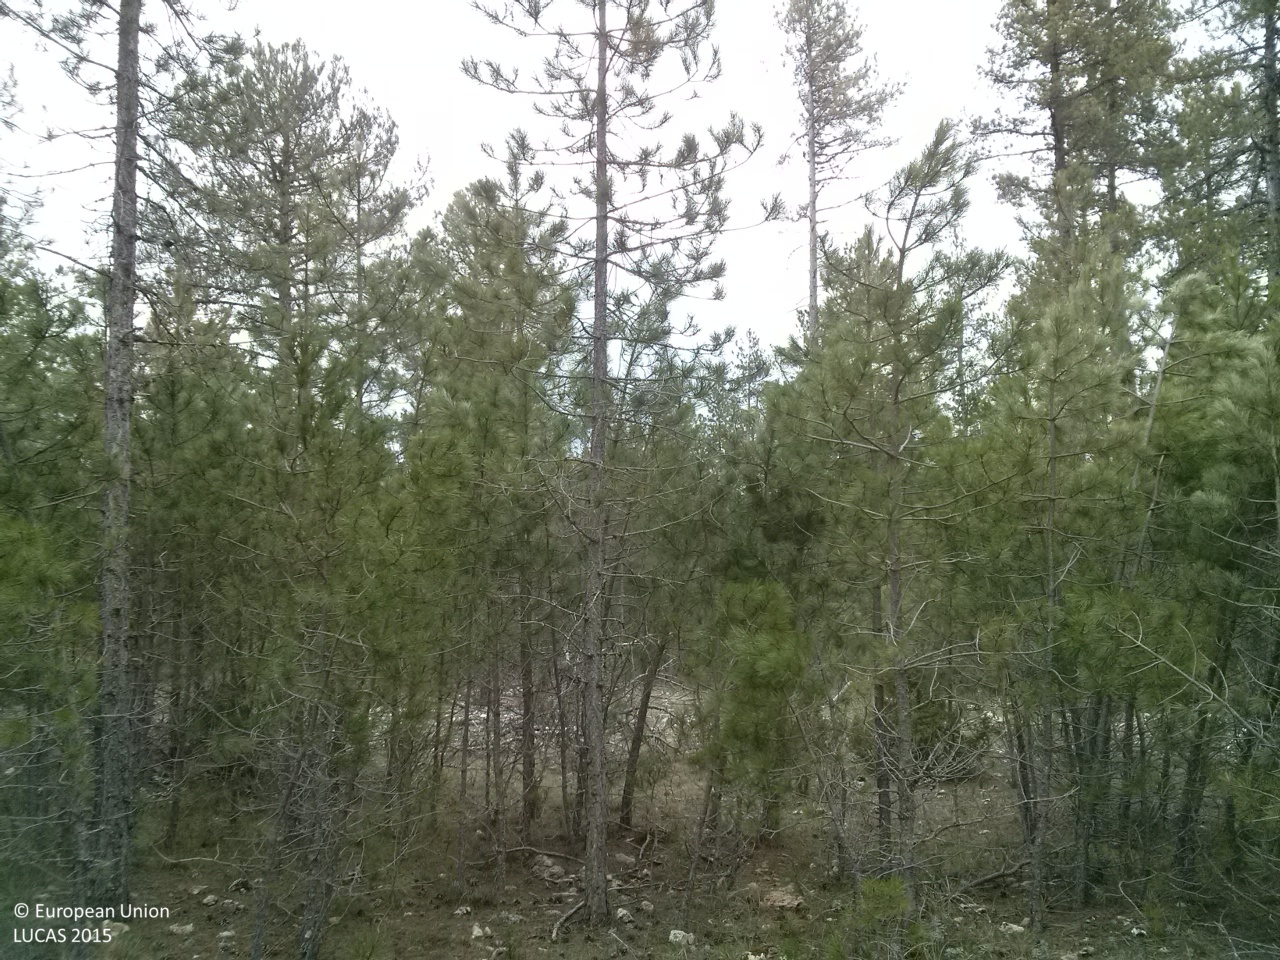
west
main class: Woodland
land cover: Pine dominated coniferous woodland
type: coniferous forest of the mediterranean region
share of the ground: 25 - 50 %
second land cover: Grassland without tree/shrub cover
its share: > 75 %
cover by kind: herbaceous plants 60 %, coniferous forest trees 40 %
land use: Forestry
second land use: Agriculture (excluding fallow land and kitchen gardens)
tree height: > 5 m
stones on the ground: 10 - 25 %
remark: Burnt area
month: April
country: ES
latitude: 40.2468
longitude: -1.9482
